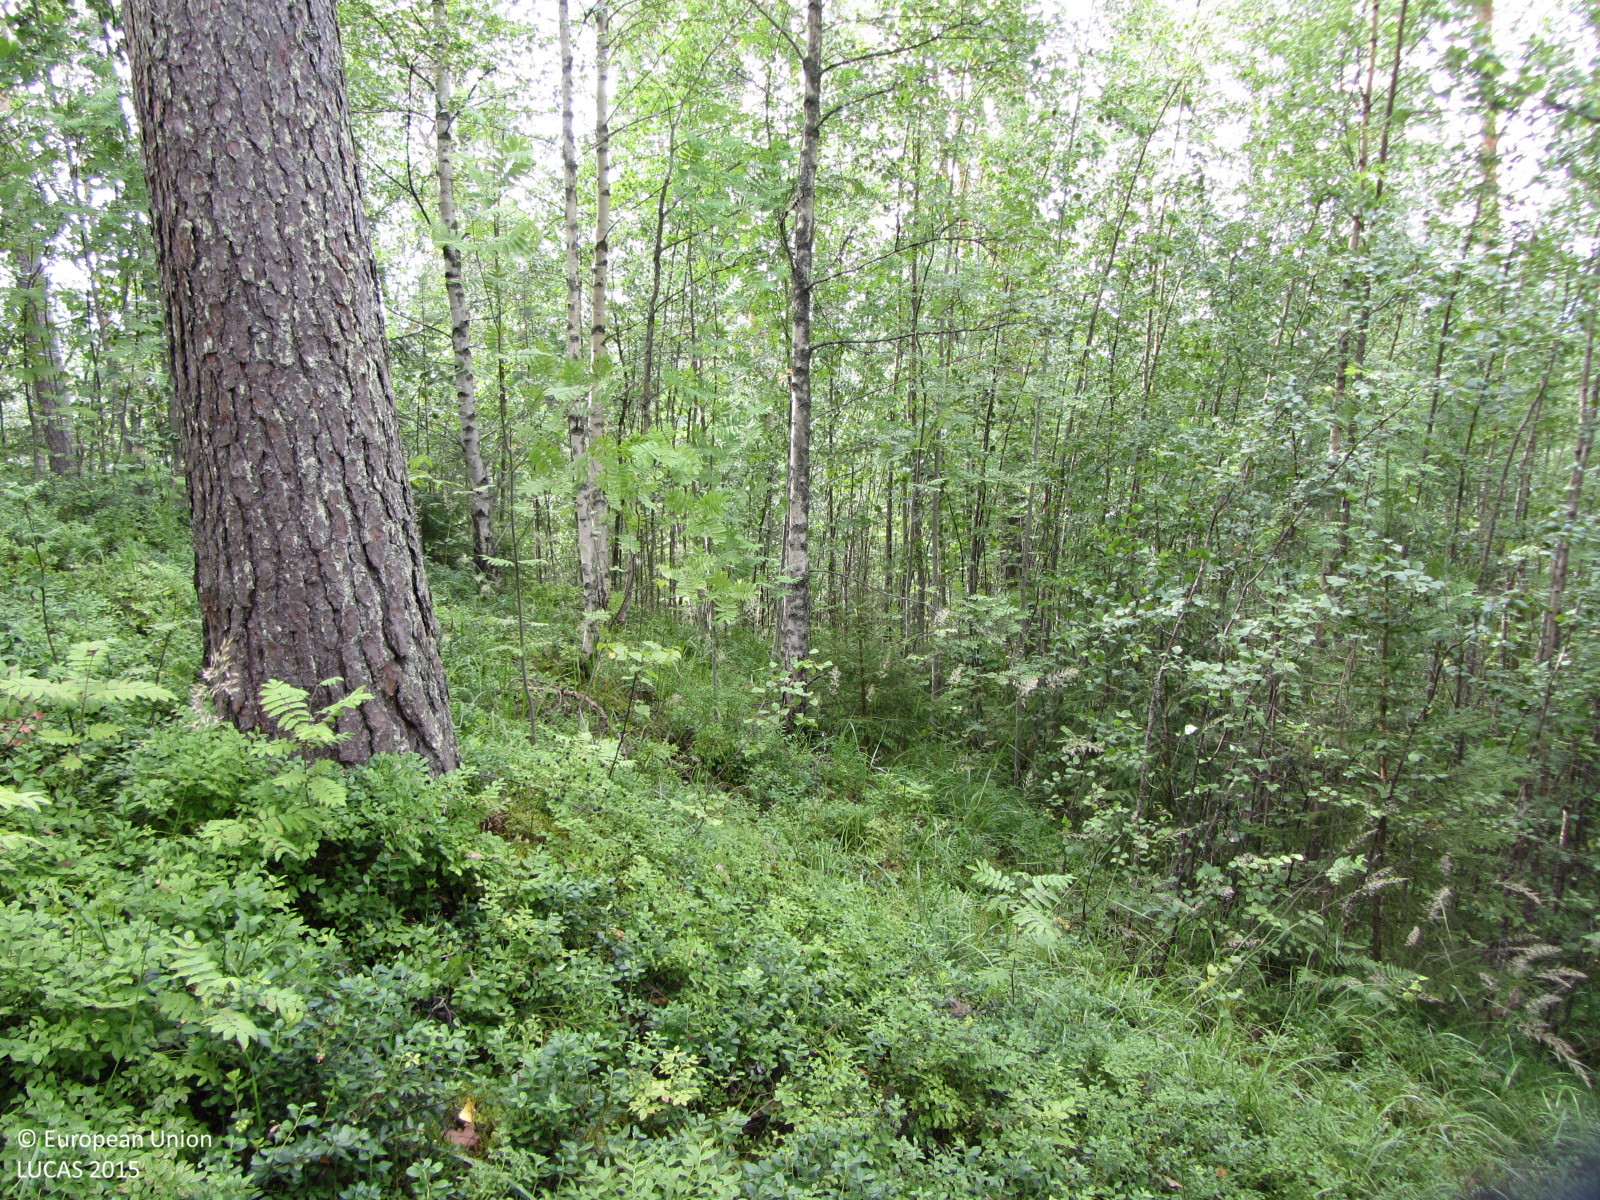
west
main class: Woodland
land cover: Pine dominated mixed woodland
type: boreal forest
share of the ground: 50 - 75 %
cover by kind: broadleaved forest trees 35 %, shrubs 35 %, coniferous forest trees 25 %, herbaceous plants 5 %
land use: Forestry
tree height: > 5 m
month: August
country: FI
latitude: 60.6581
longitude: 24.6527
